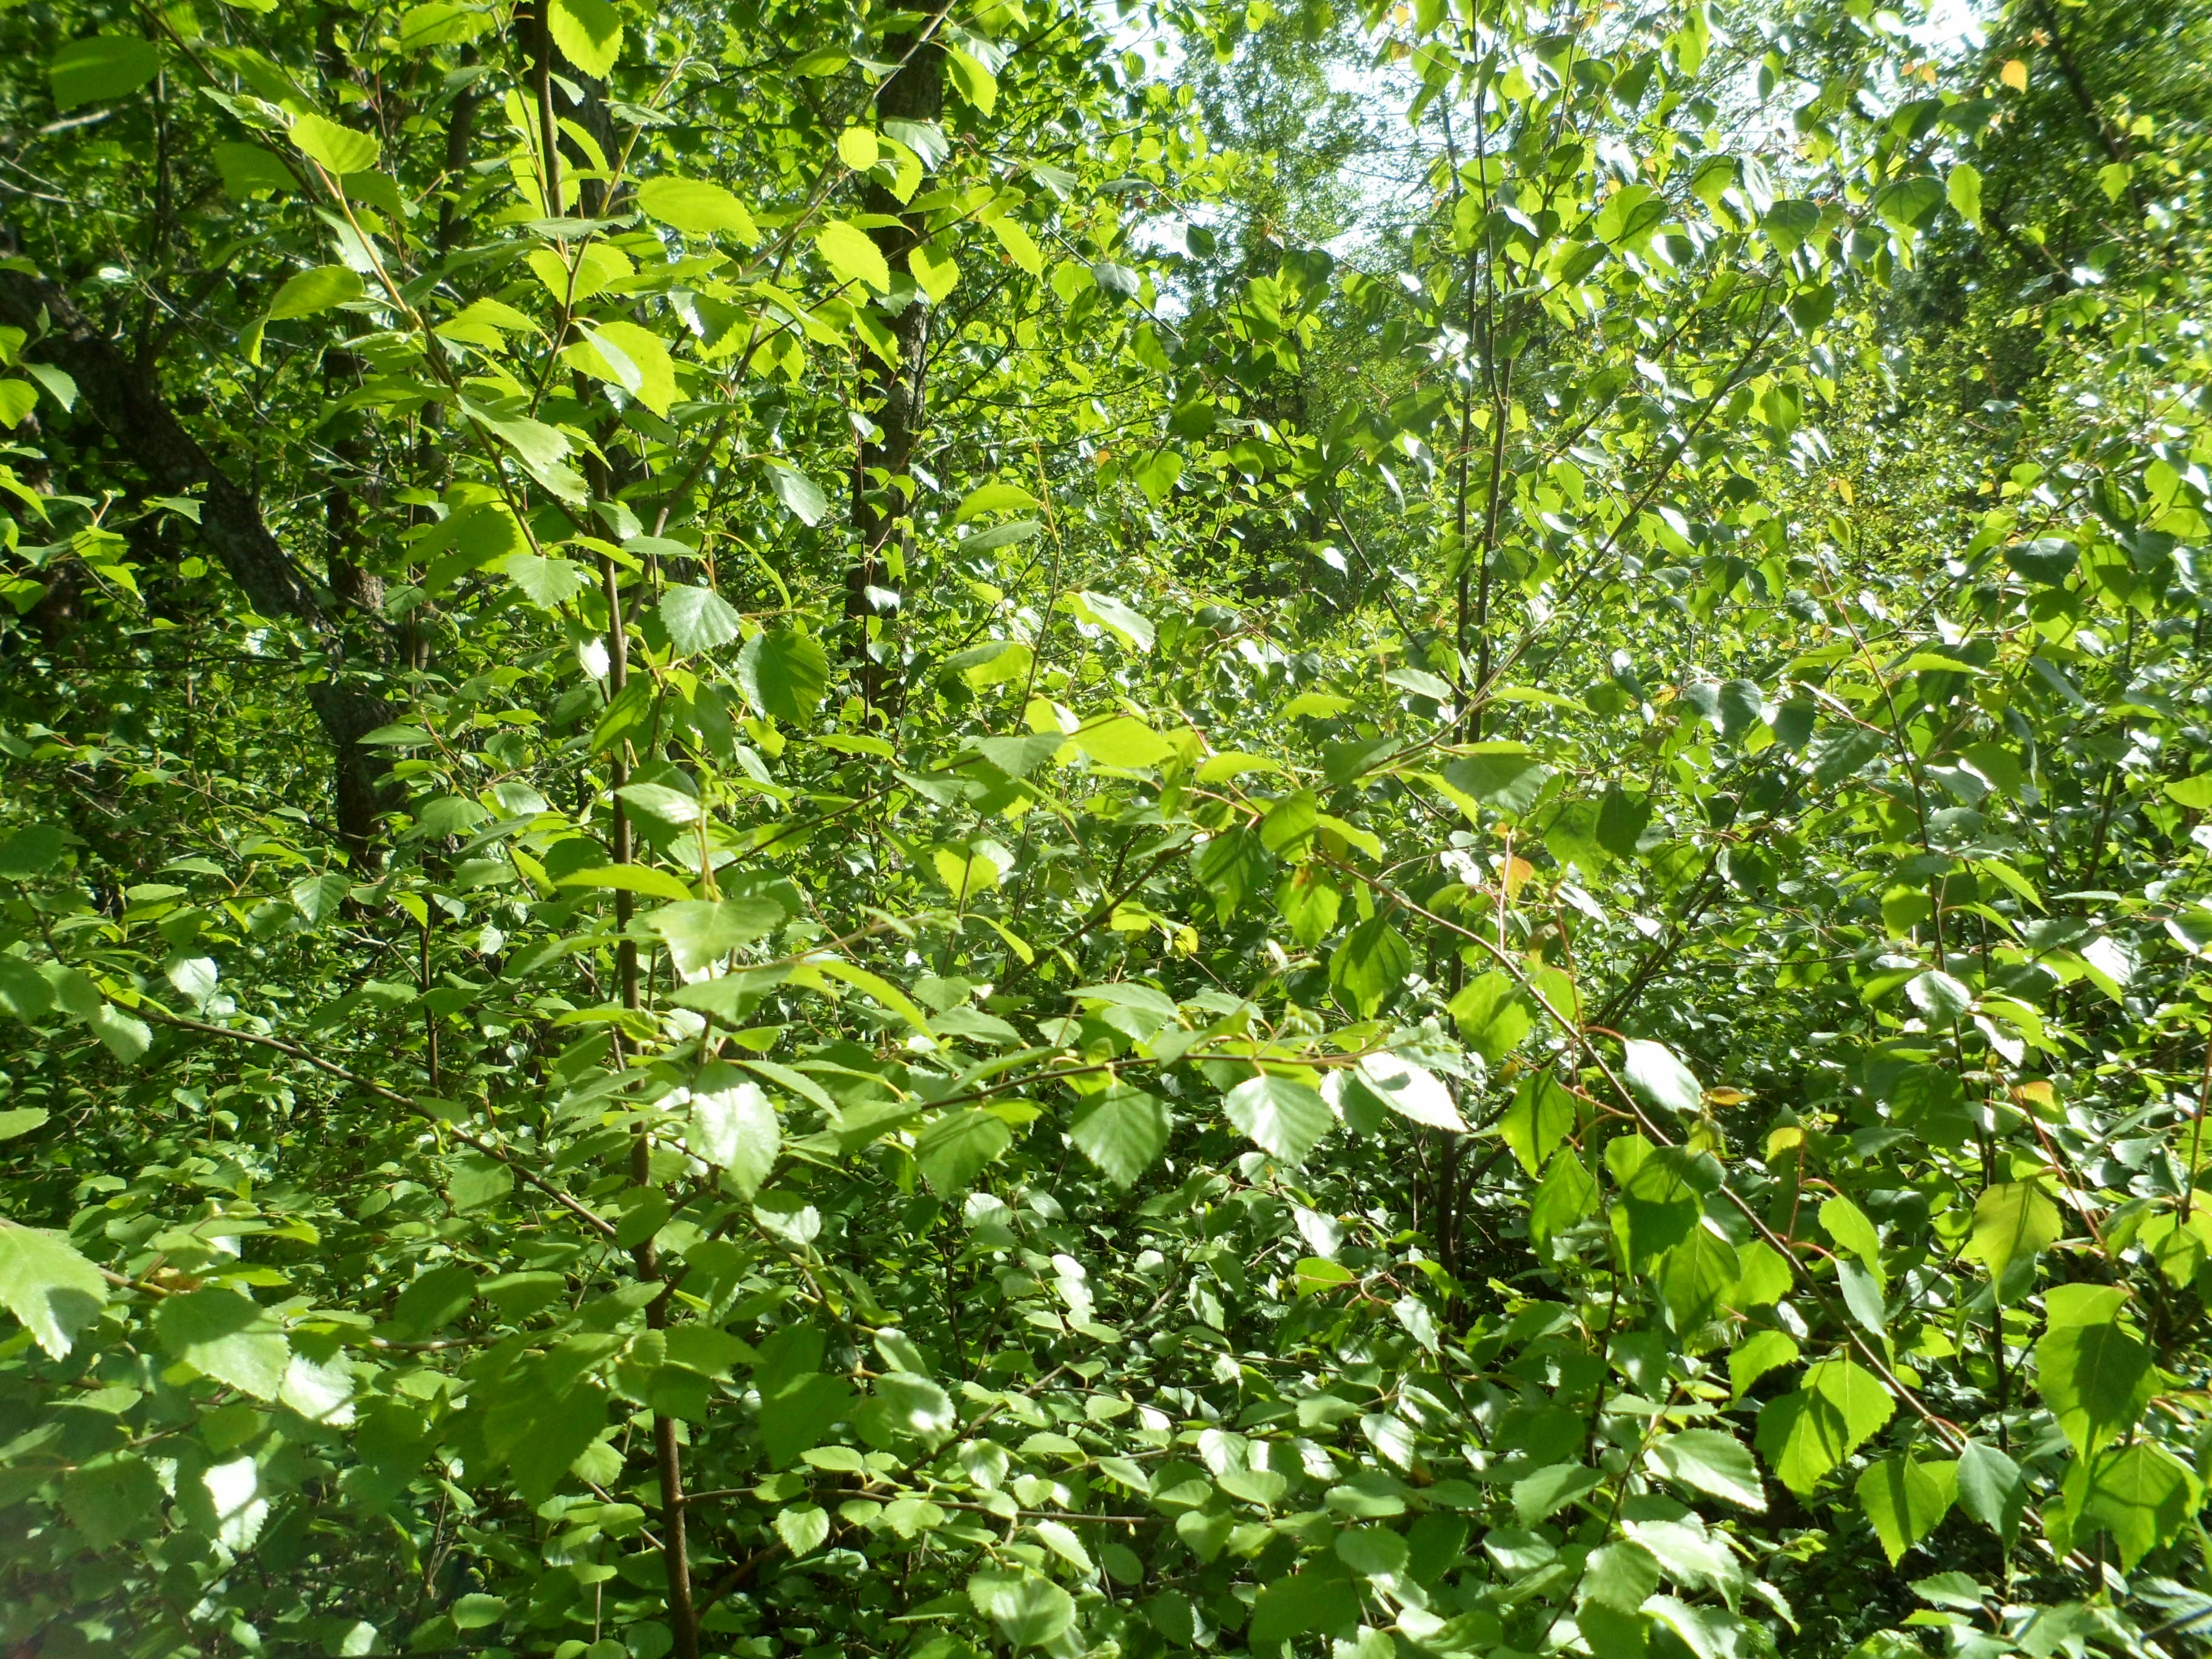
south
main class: Woodland
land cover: Broadleaved woodland
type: boreal forest
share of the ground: > 75 %
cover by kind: broadleaved forest trees 90 %, herbaceous plants 5 %, unconsolidated bare surface 5 %
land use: Forestry
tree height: < 5 m
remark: Clear cut
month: June
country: SE
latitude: 56.9955
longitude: 14.8858
